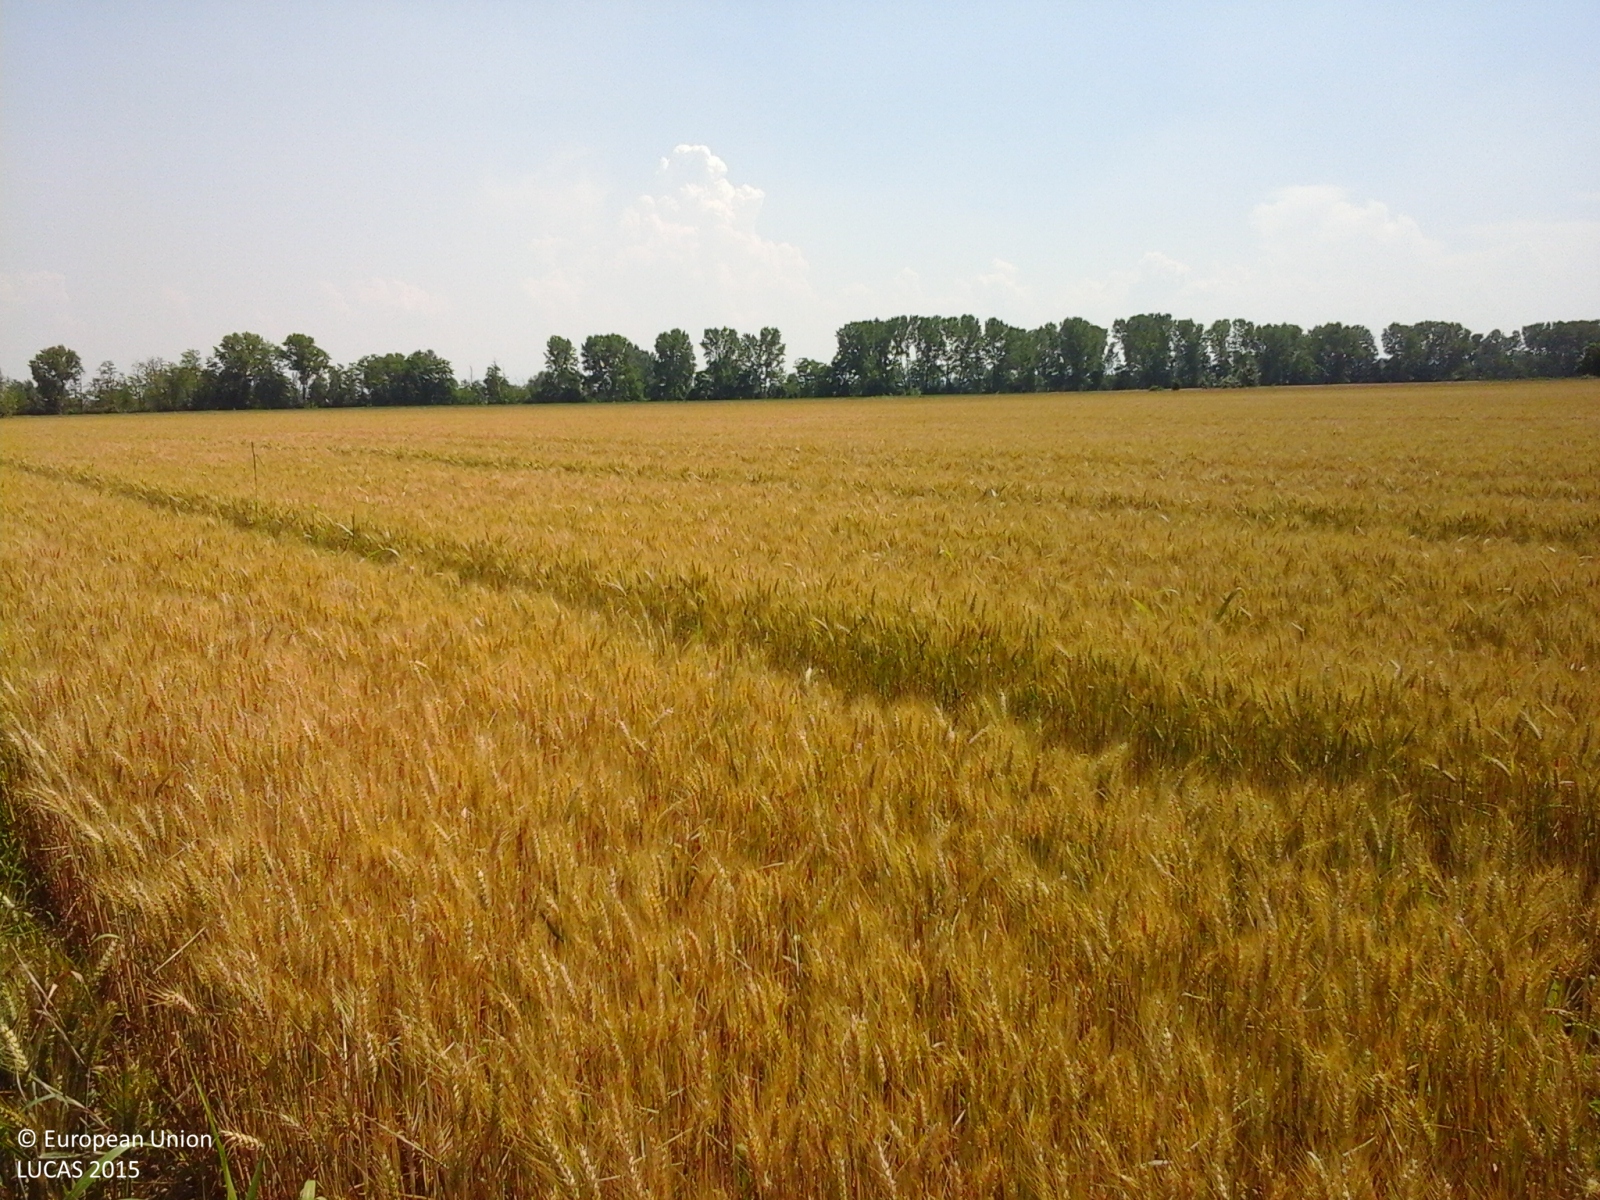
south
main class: Cropland
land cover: Common wheat
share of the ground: > 75 %
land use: Agriculture (excluding fallow land and kitchen gardens)
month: June
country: IT
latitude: 44.8638
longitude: 8.5727
